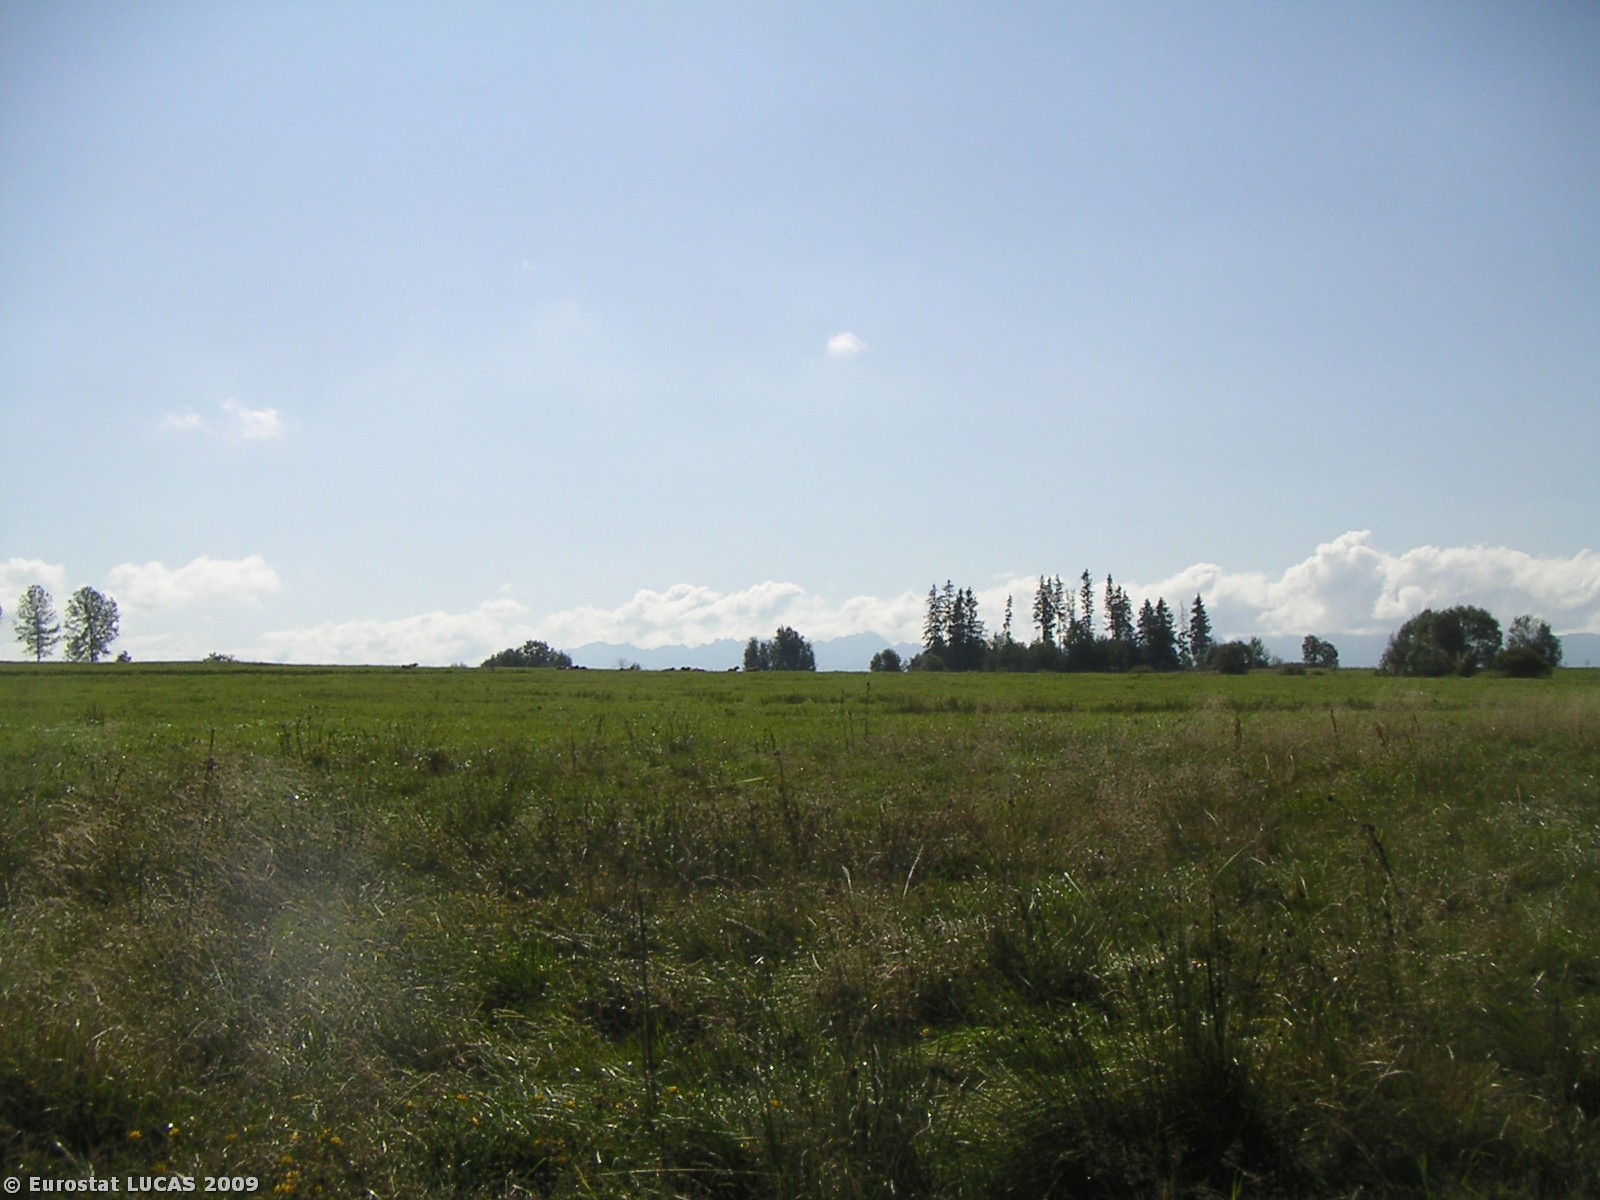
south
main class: Grassland
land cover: Spontaneously vegetated surfaces
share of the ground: > 75 %
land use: Fallow land
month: September
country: PL
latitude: 49.4118
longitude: 19.8574
